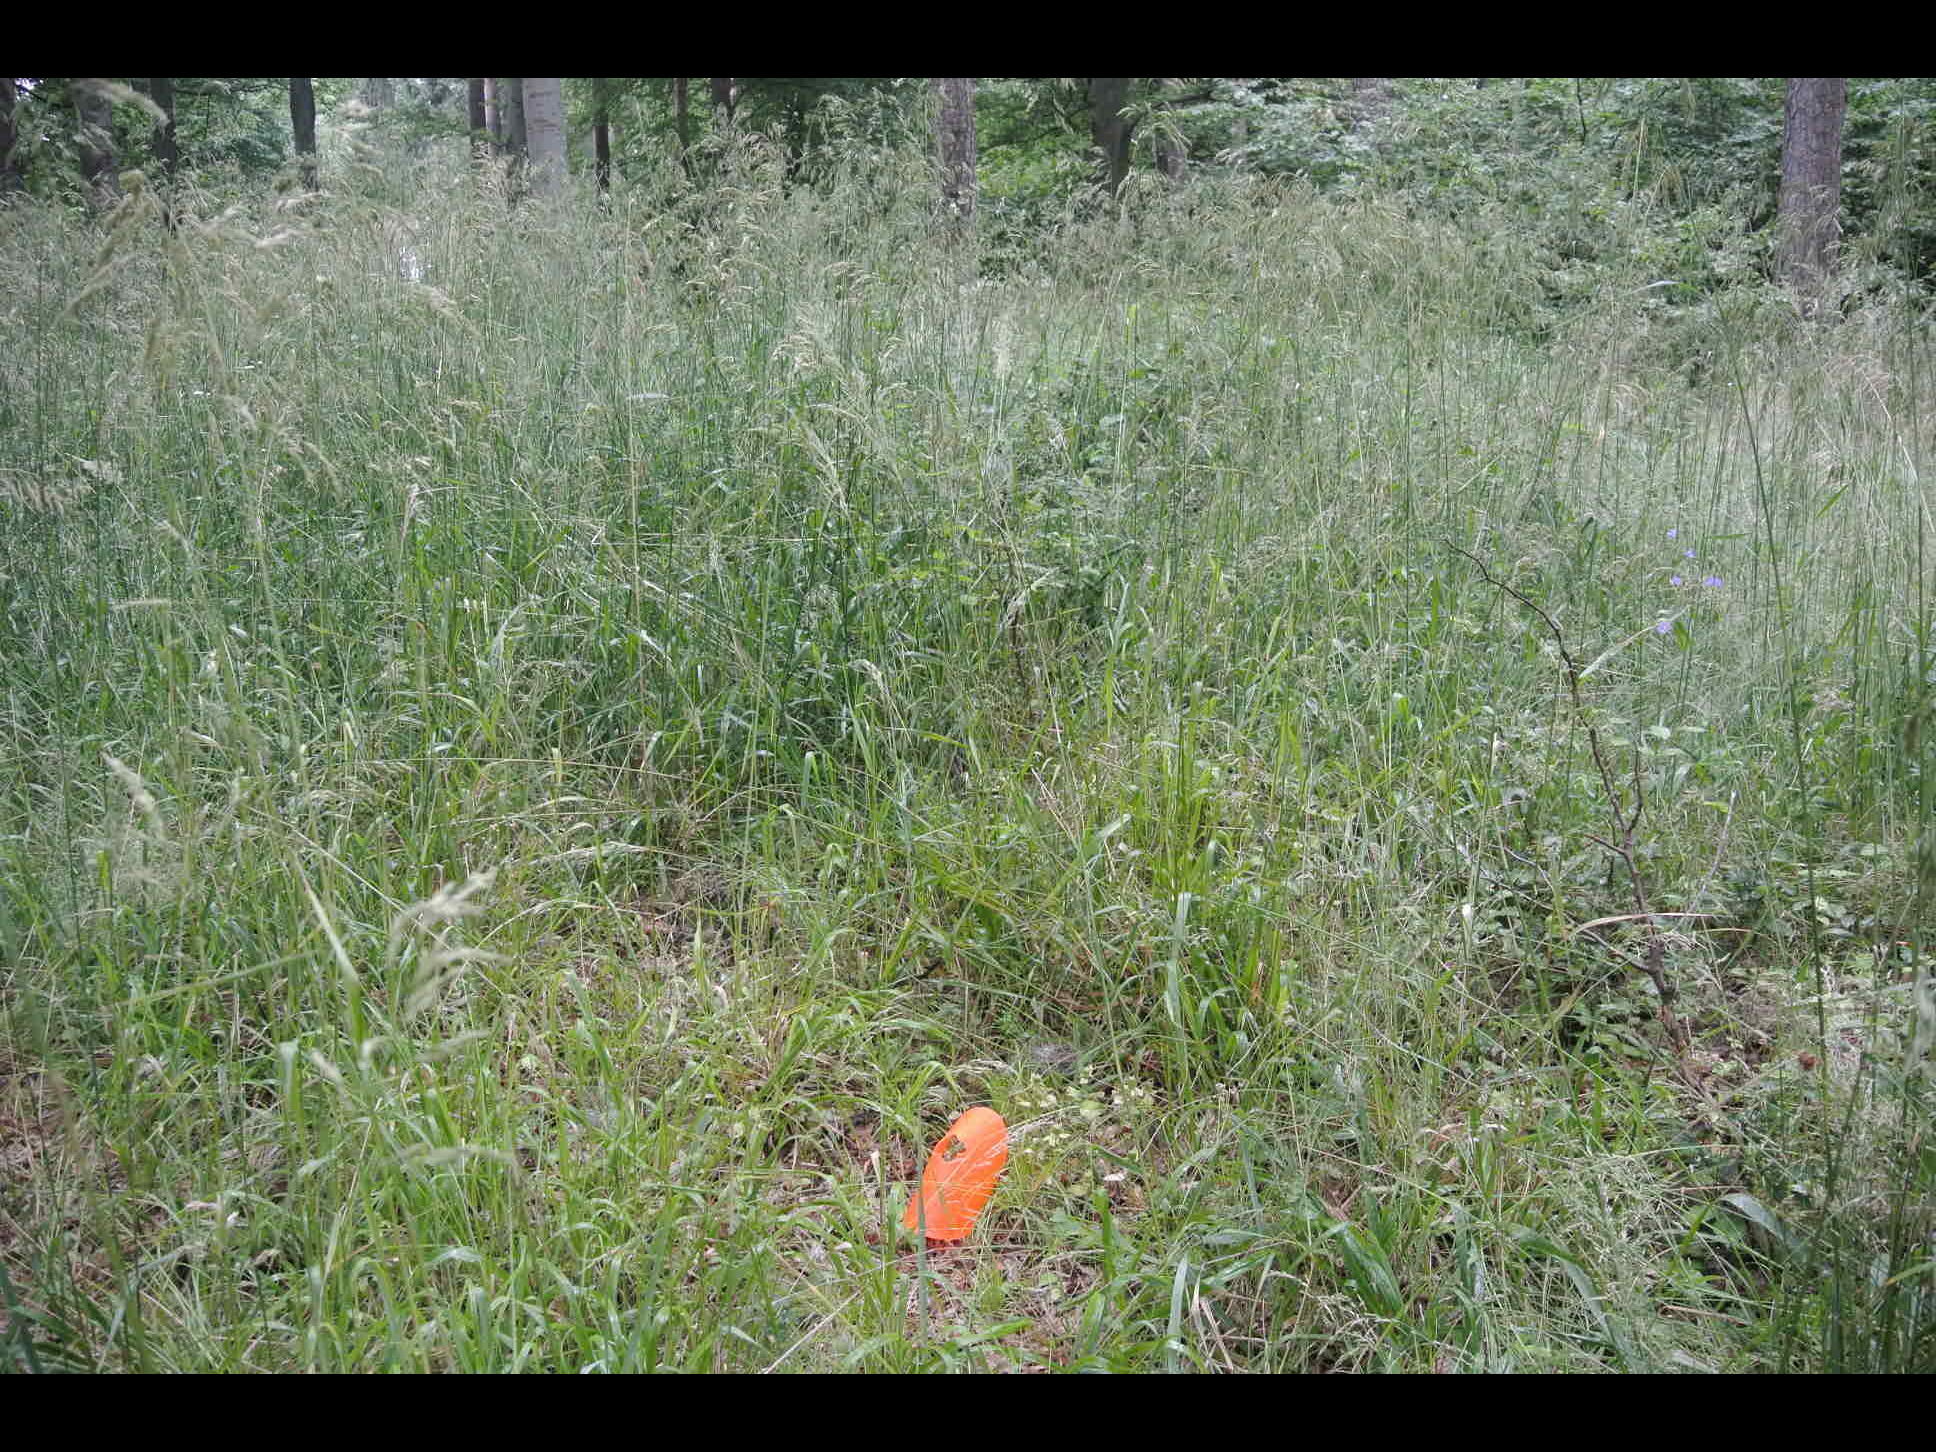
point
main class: Woodland
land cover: Pine dominated mixed woodland
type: alpine coniferous forest
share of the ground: > 75 %
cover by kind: broadleaved forest trees 45 %, coniferous forest trees 35 %, herbaceous plants 20 %
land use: Forestry
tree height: > 5 m
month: July
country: AT
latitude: 47.6400
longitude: 16.4062
